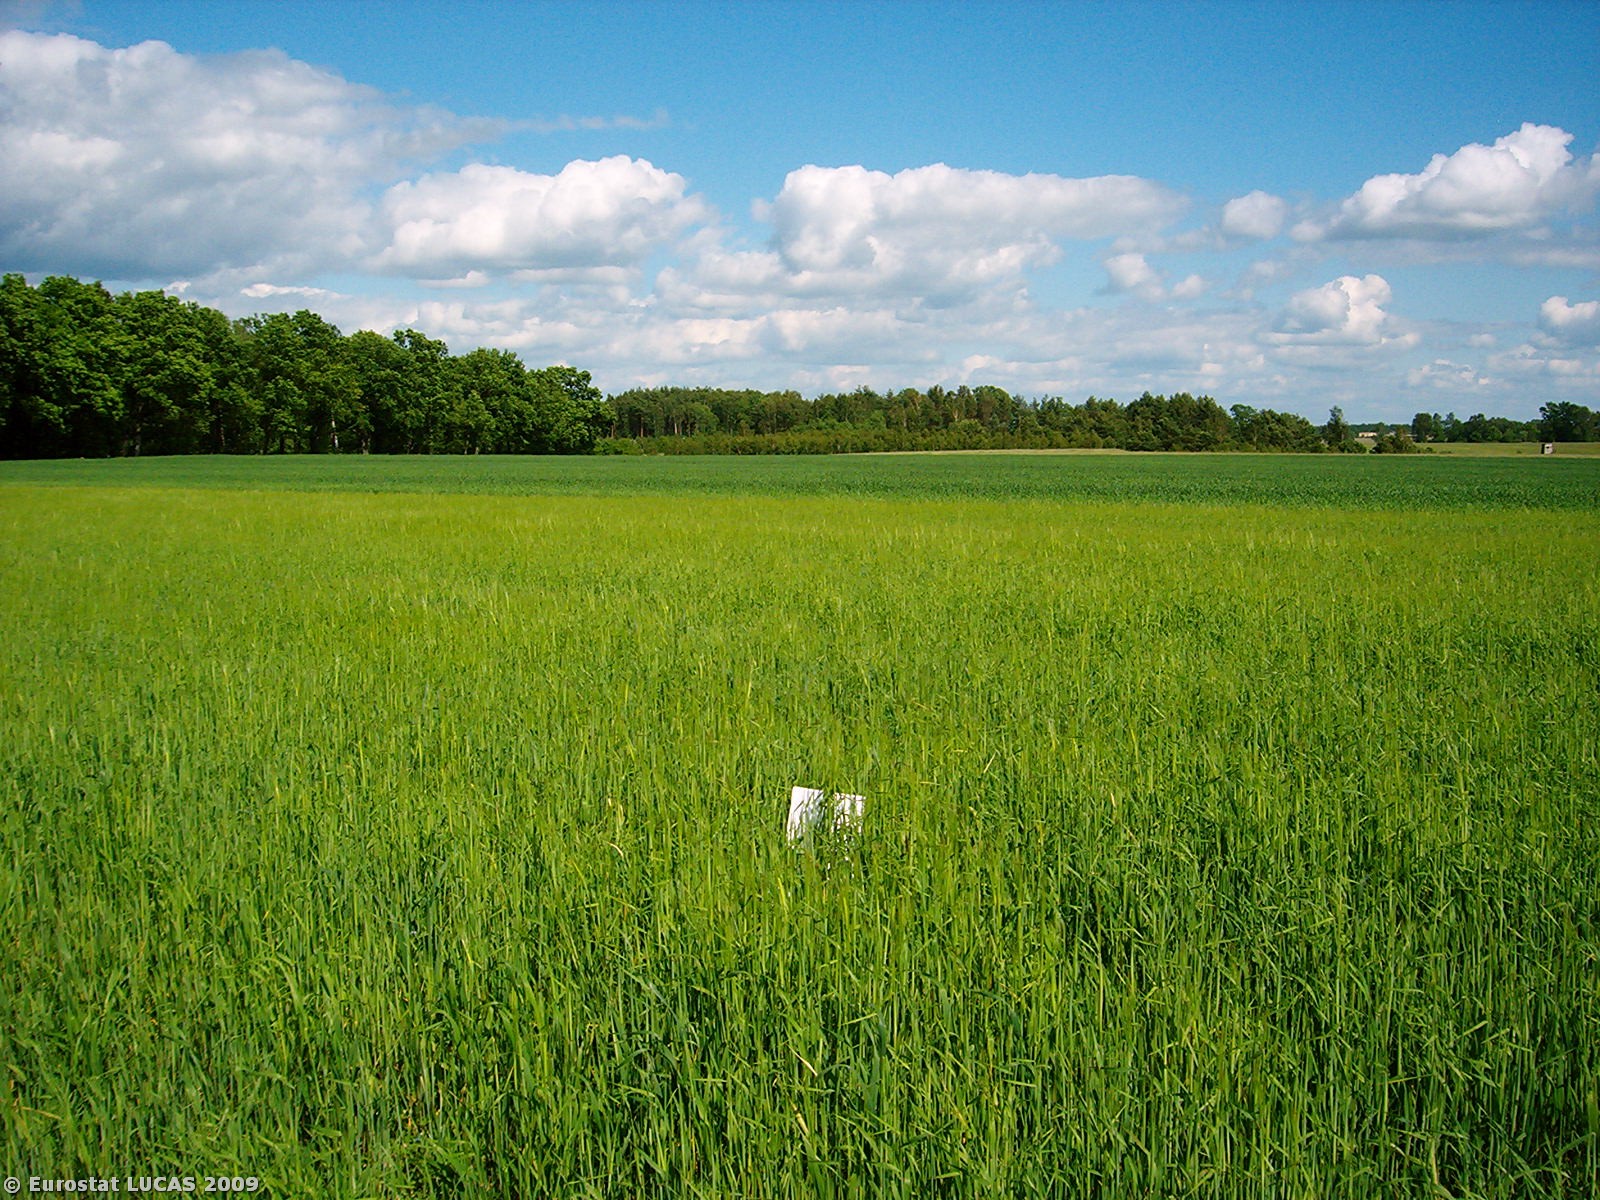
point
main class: Cropland
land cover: Barley
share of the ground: > 75 %
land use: Agriculture (excluding fallow land and kitchen gardens)
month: June
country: PL
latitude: 53.6588
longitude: 17.1672
